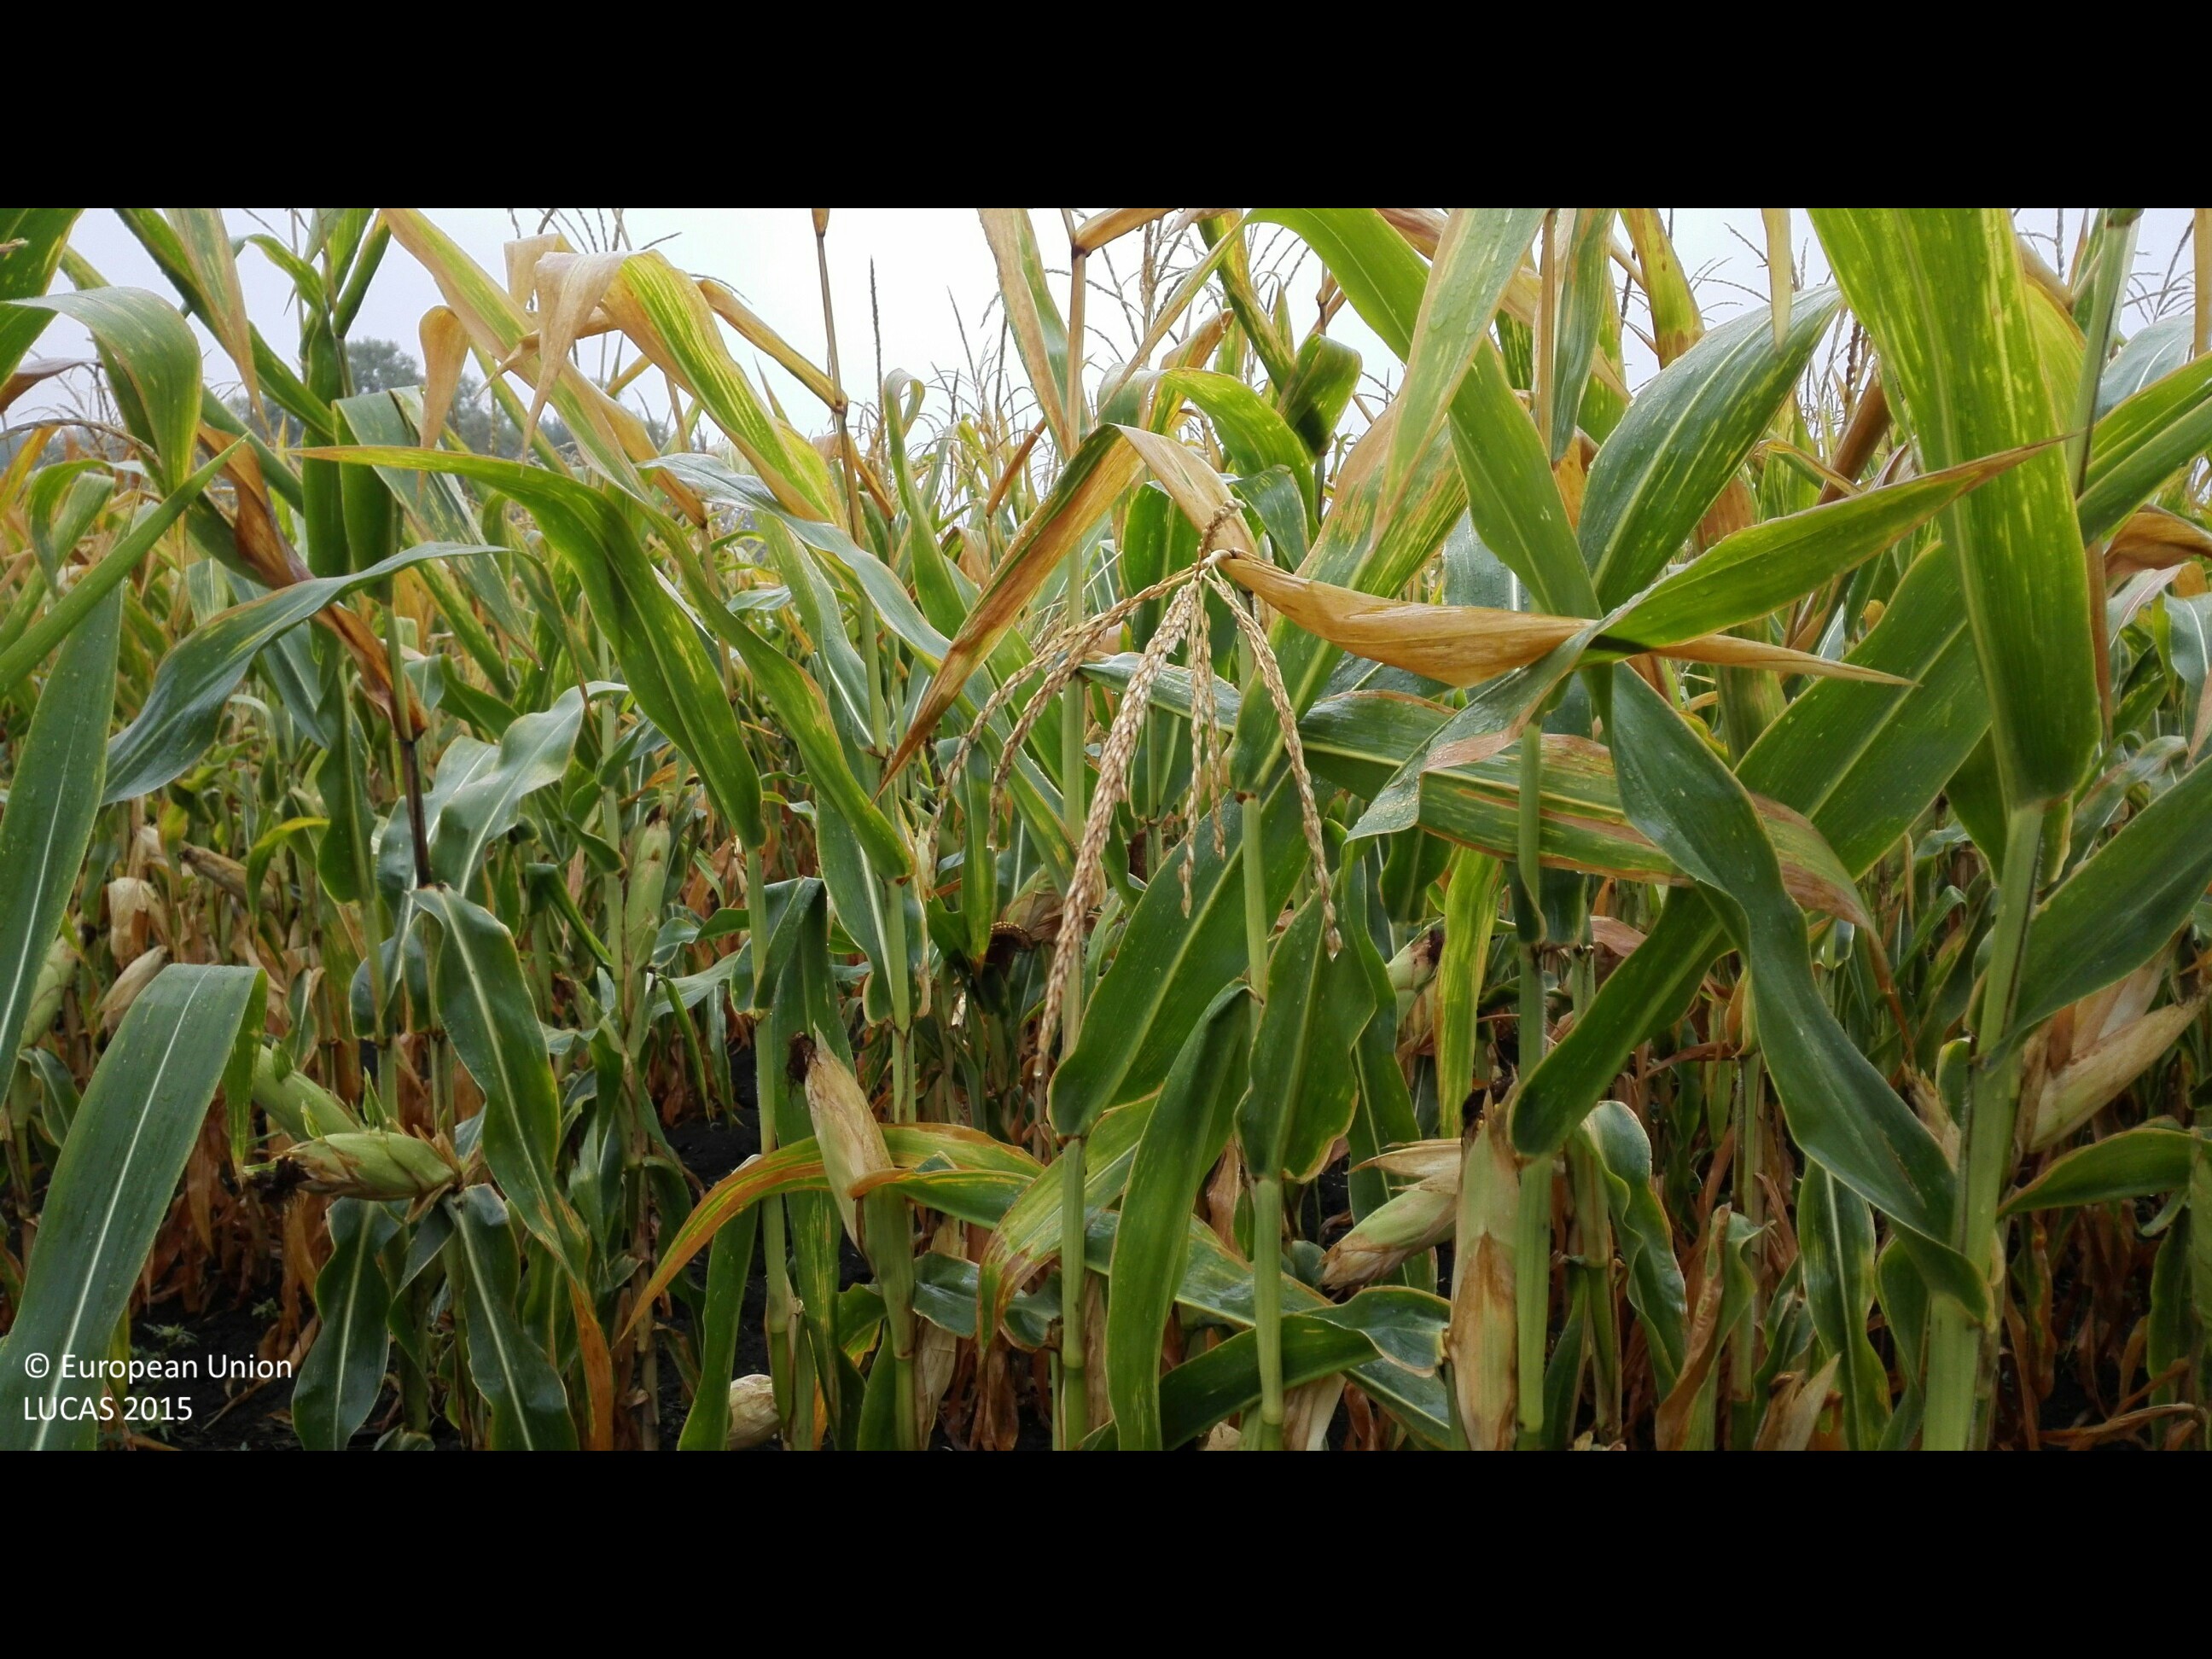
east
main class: Cropland
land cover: Maize
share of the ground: > 75 %
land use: Agriculture (excluding fallow land and kitchen gardens)
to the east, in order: Maize; Spontaneously vegetated surfaces; Lucerne; Tracks; Grassland without tree/shrub cover; Grassland with sparse tree/shrub cover; Common wheat
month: August
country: HU
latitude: 47.2216
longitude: 21.6513
